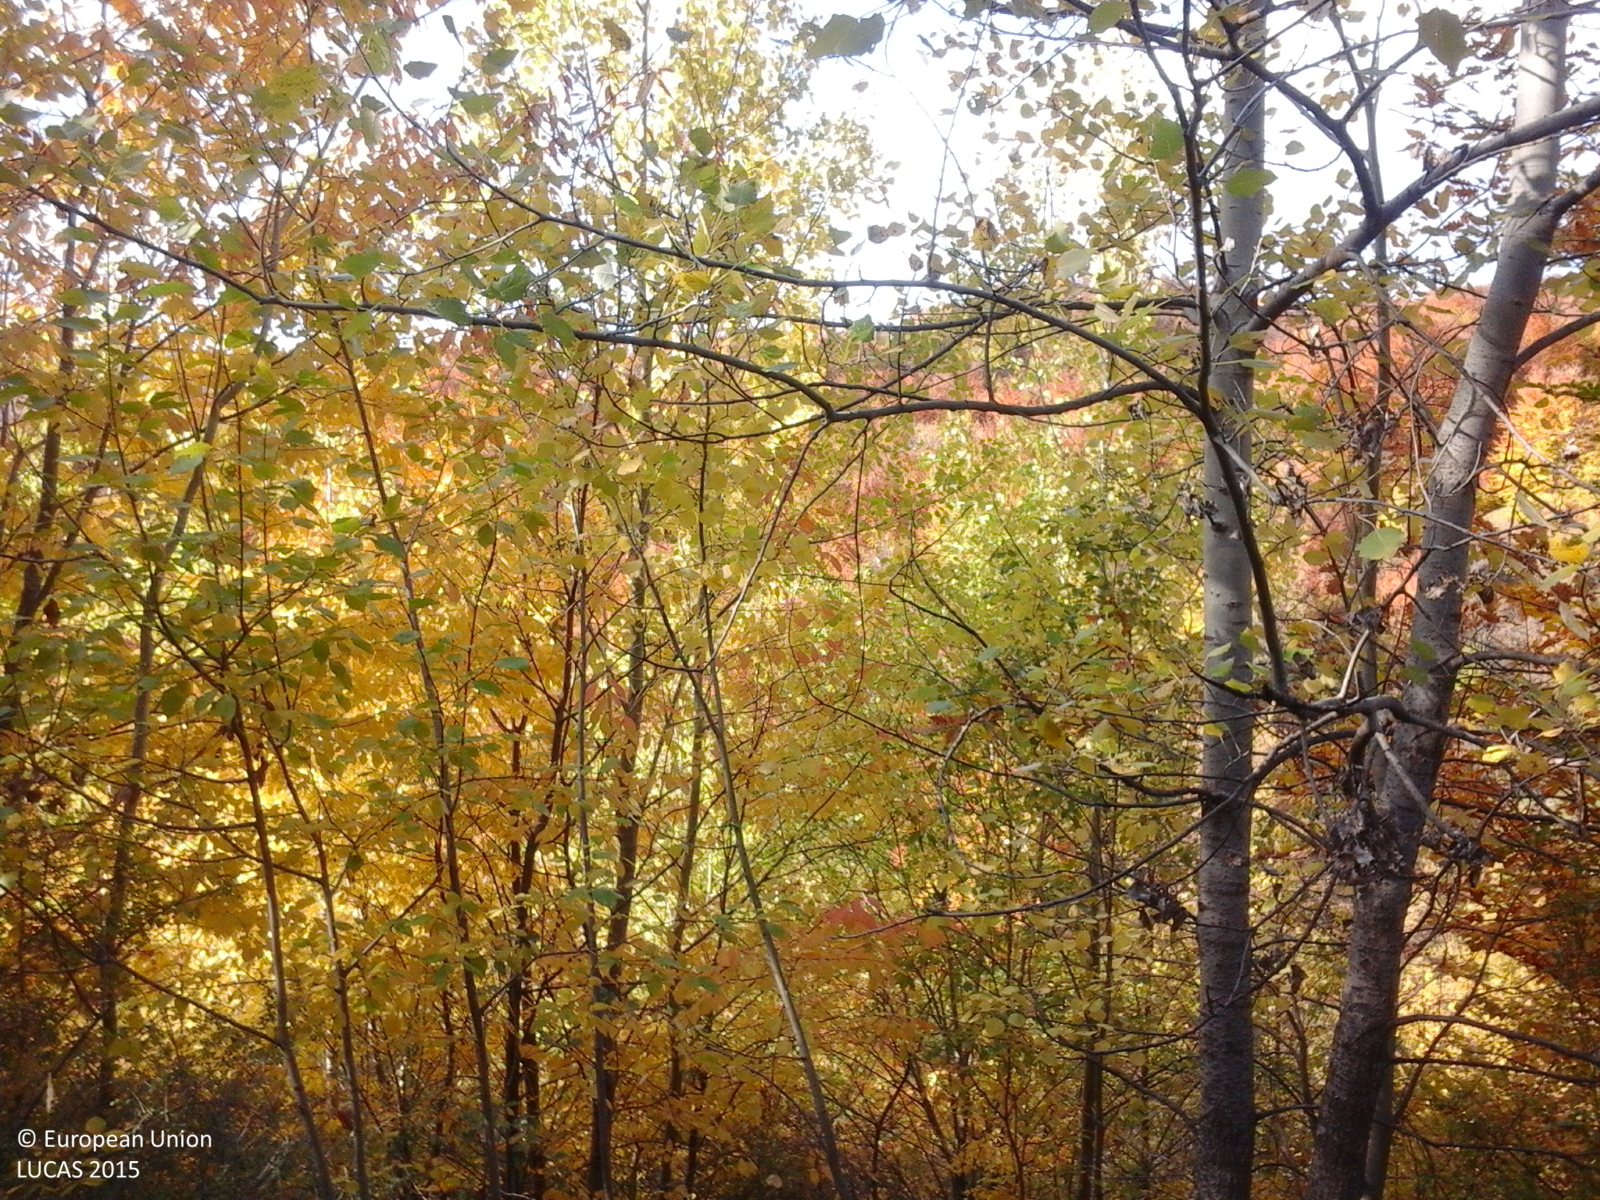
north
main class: Woodland
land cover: Broadleaved woodland
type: beech forest
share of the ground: > 75 %
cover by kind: broadleaved forest trees 100 %
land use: Forestry
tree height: > 5 m
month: October
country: RO
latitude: 45.6058
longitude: 26.8687
